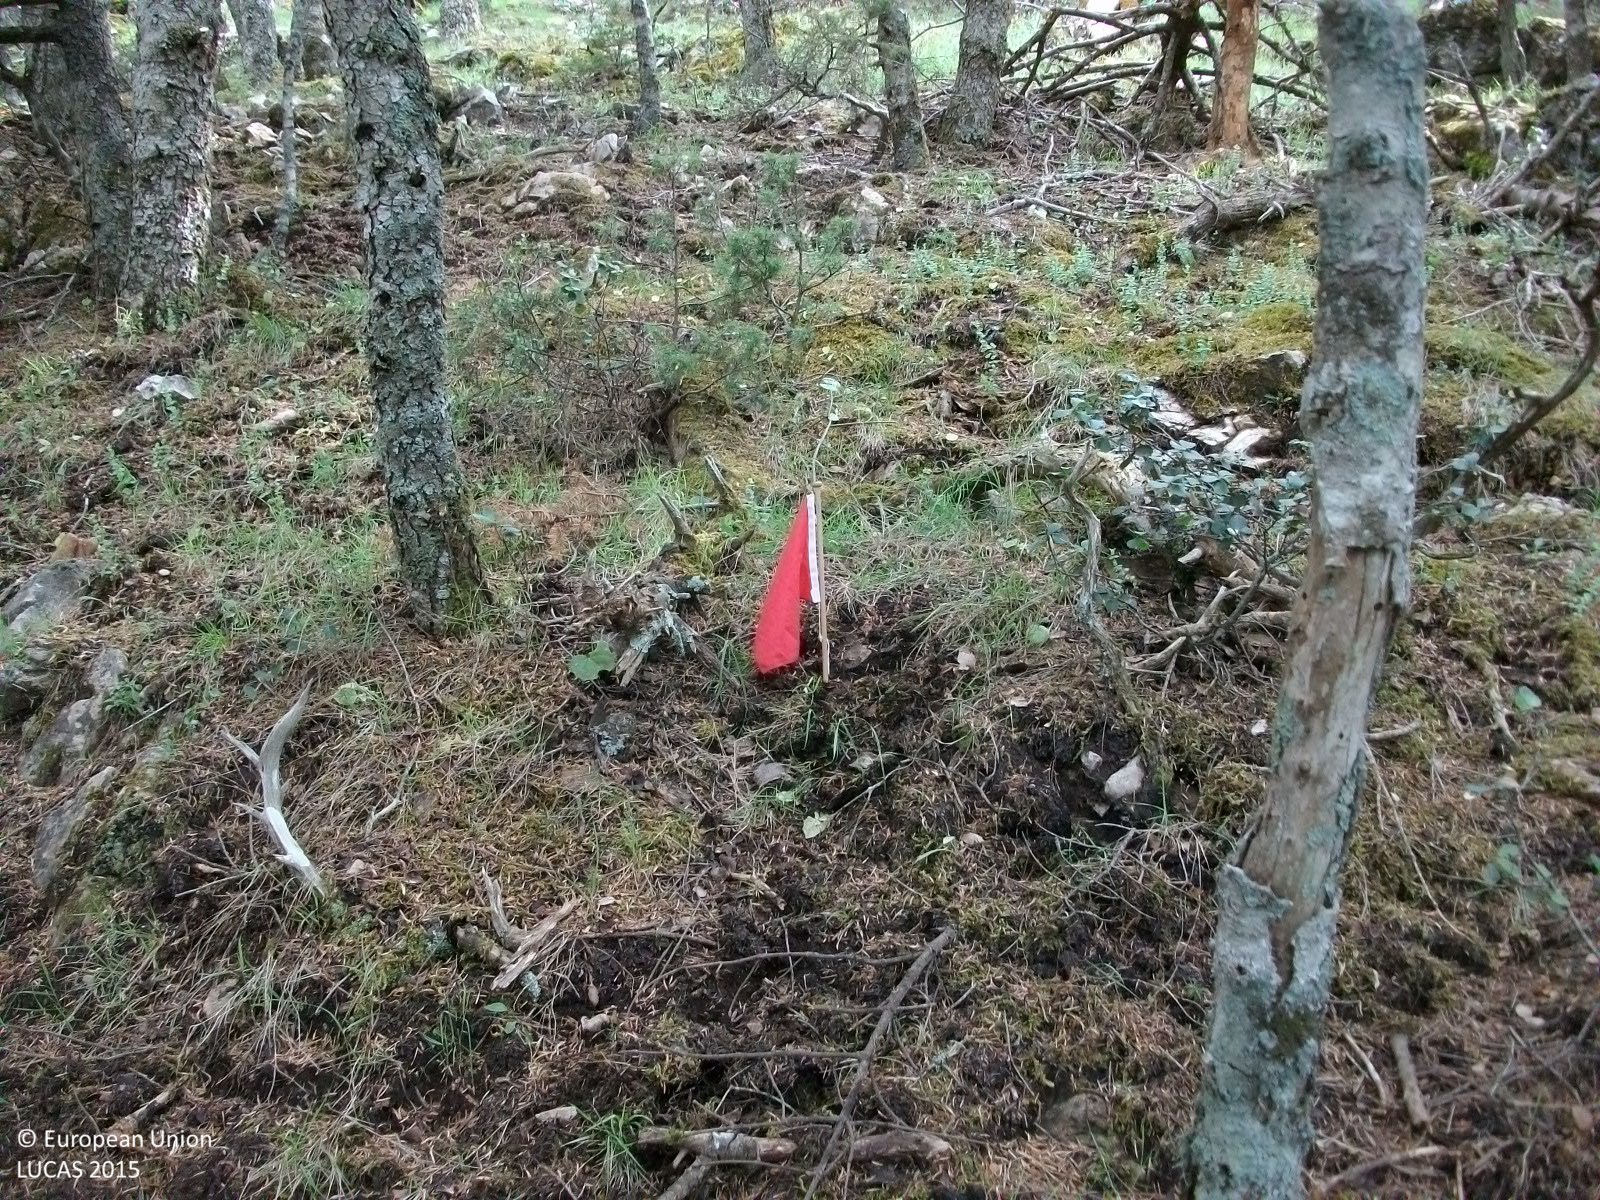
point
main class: Woodland
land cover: Spruce dominated coniferous woodland
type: coniferous forest of the mediterranean region
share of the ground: > 75 %
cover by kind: coniferous forest trees 100 %
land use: Forestry
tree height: > 5 m
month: June
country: GR
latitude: 36.8424
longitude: 22.3885
